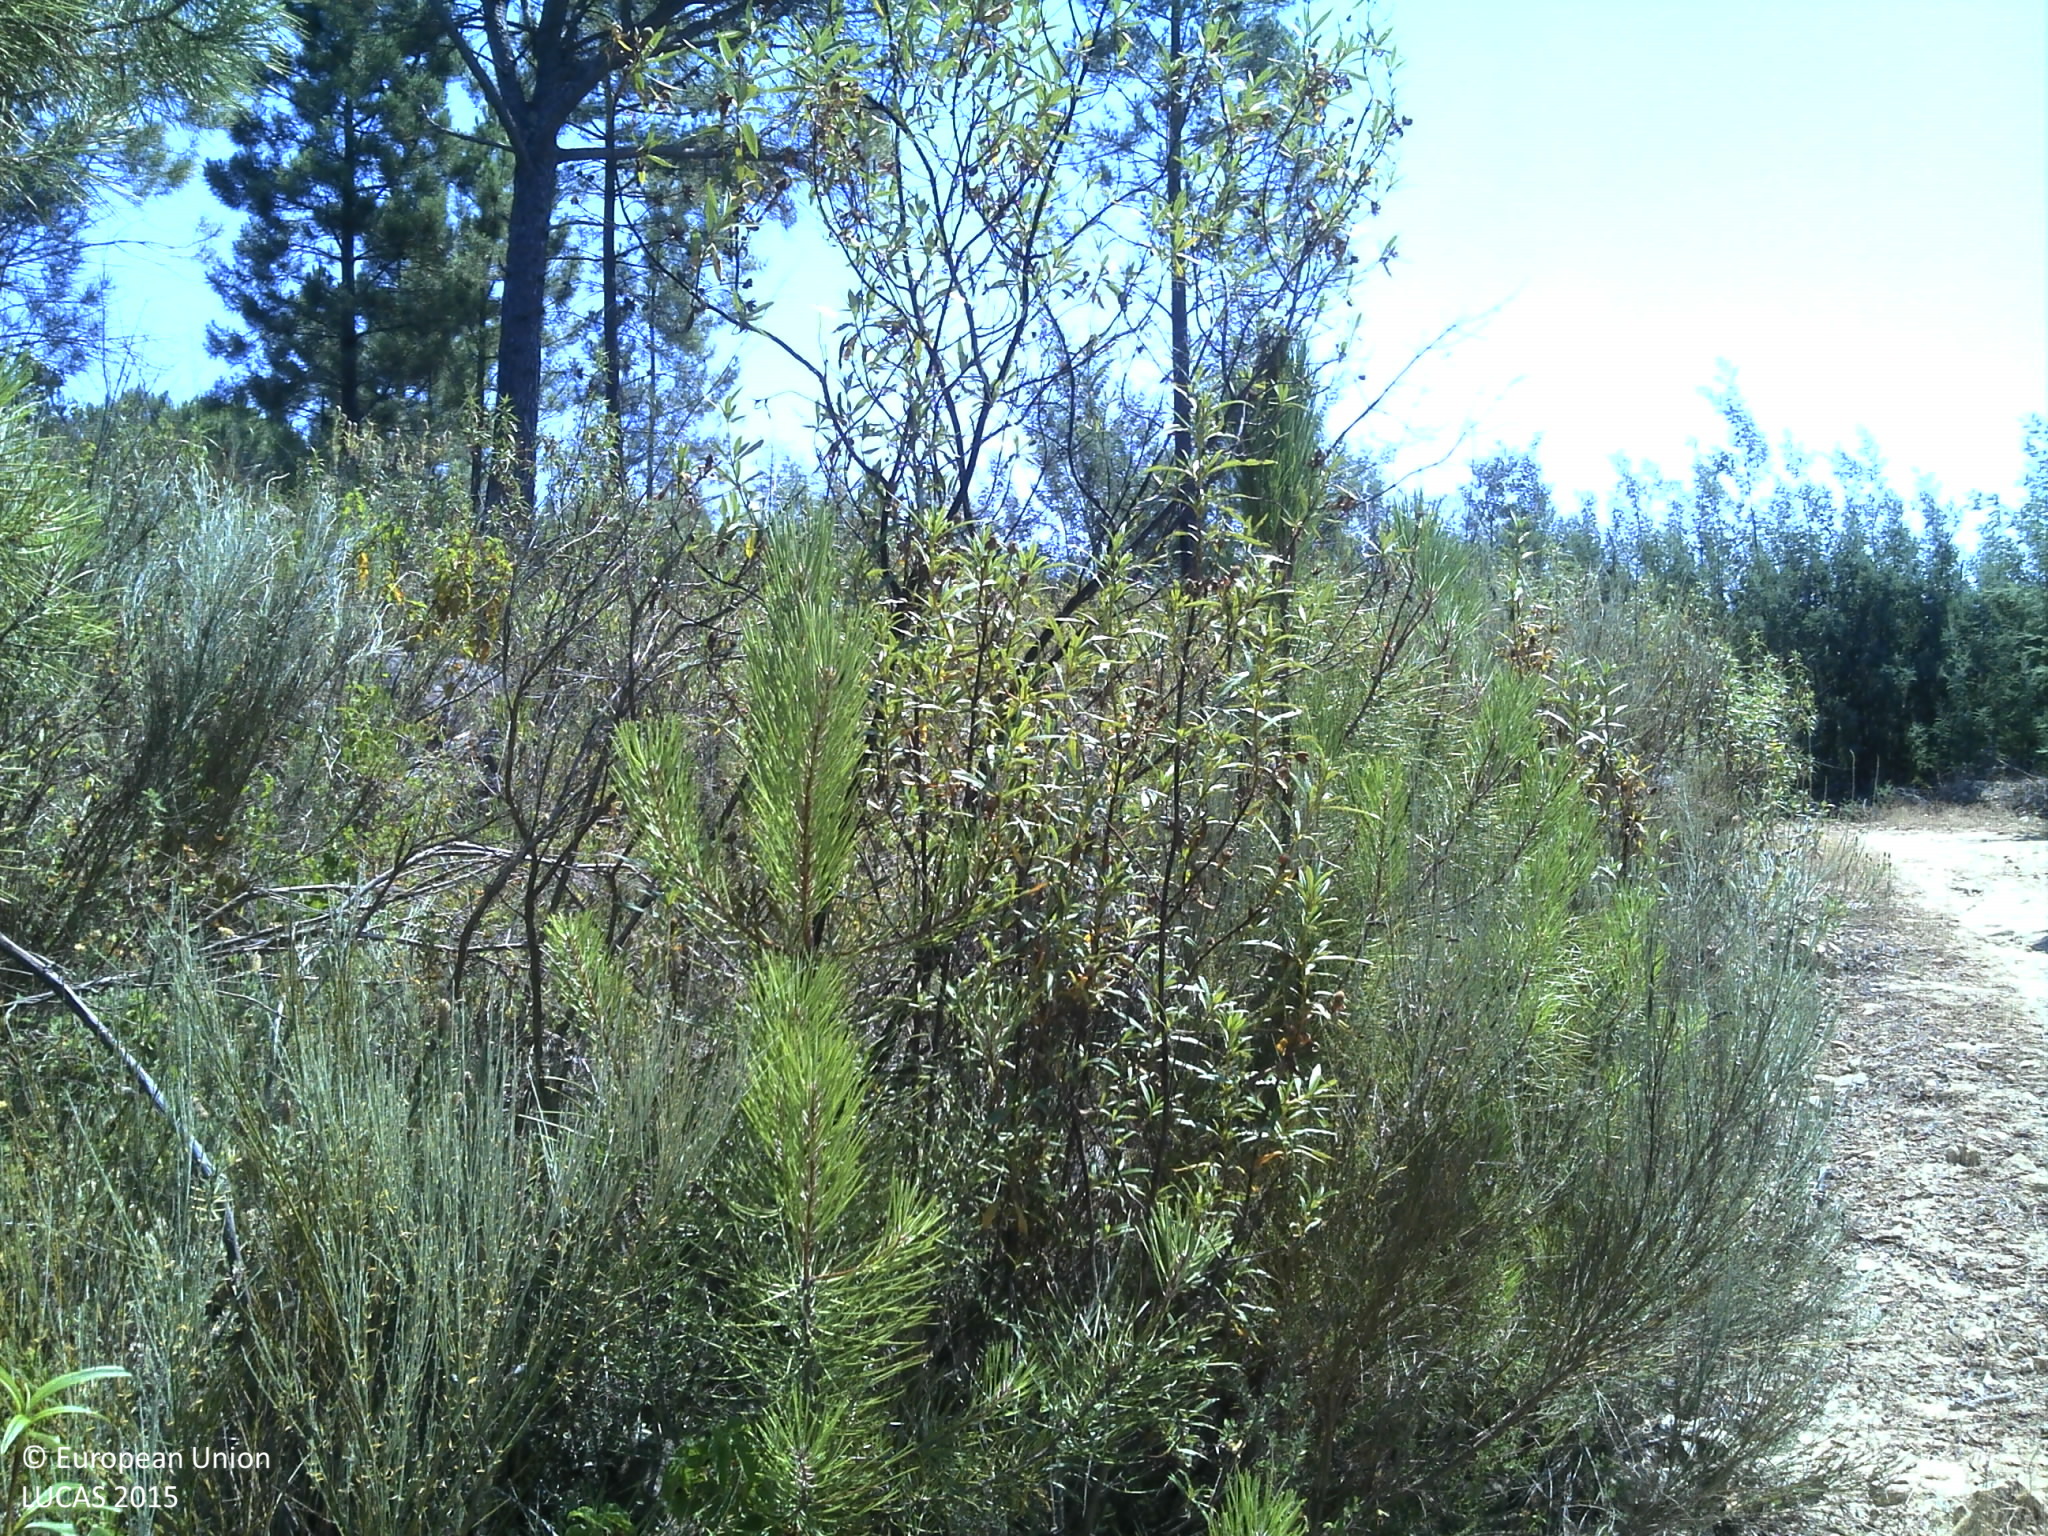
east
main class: Woodland
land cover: Pine dominated coniferous woodland
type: coniferous forest of the mediterranean region
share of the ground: 25 - 50 %
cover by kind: coniferous forest trees 30 %, shrubs 30 %, herbaceous plants 20 %, consolidated bare surface 10 %, unconsolidated bare surface 10 %
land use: Forestry
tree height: > 5 m
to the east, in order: Pine dominated coniferous woodland; Shrubland with sparse tree cover; Tracks; Broadleaved woodland; Shrubland with sparse tree cover; Shrubland without tree cover; Shrubland with sparse tree cover
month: June
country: PT
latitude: 40.5112
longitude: -7.7857
